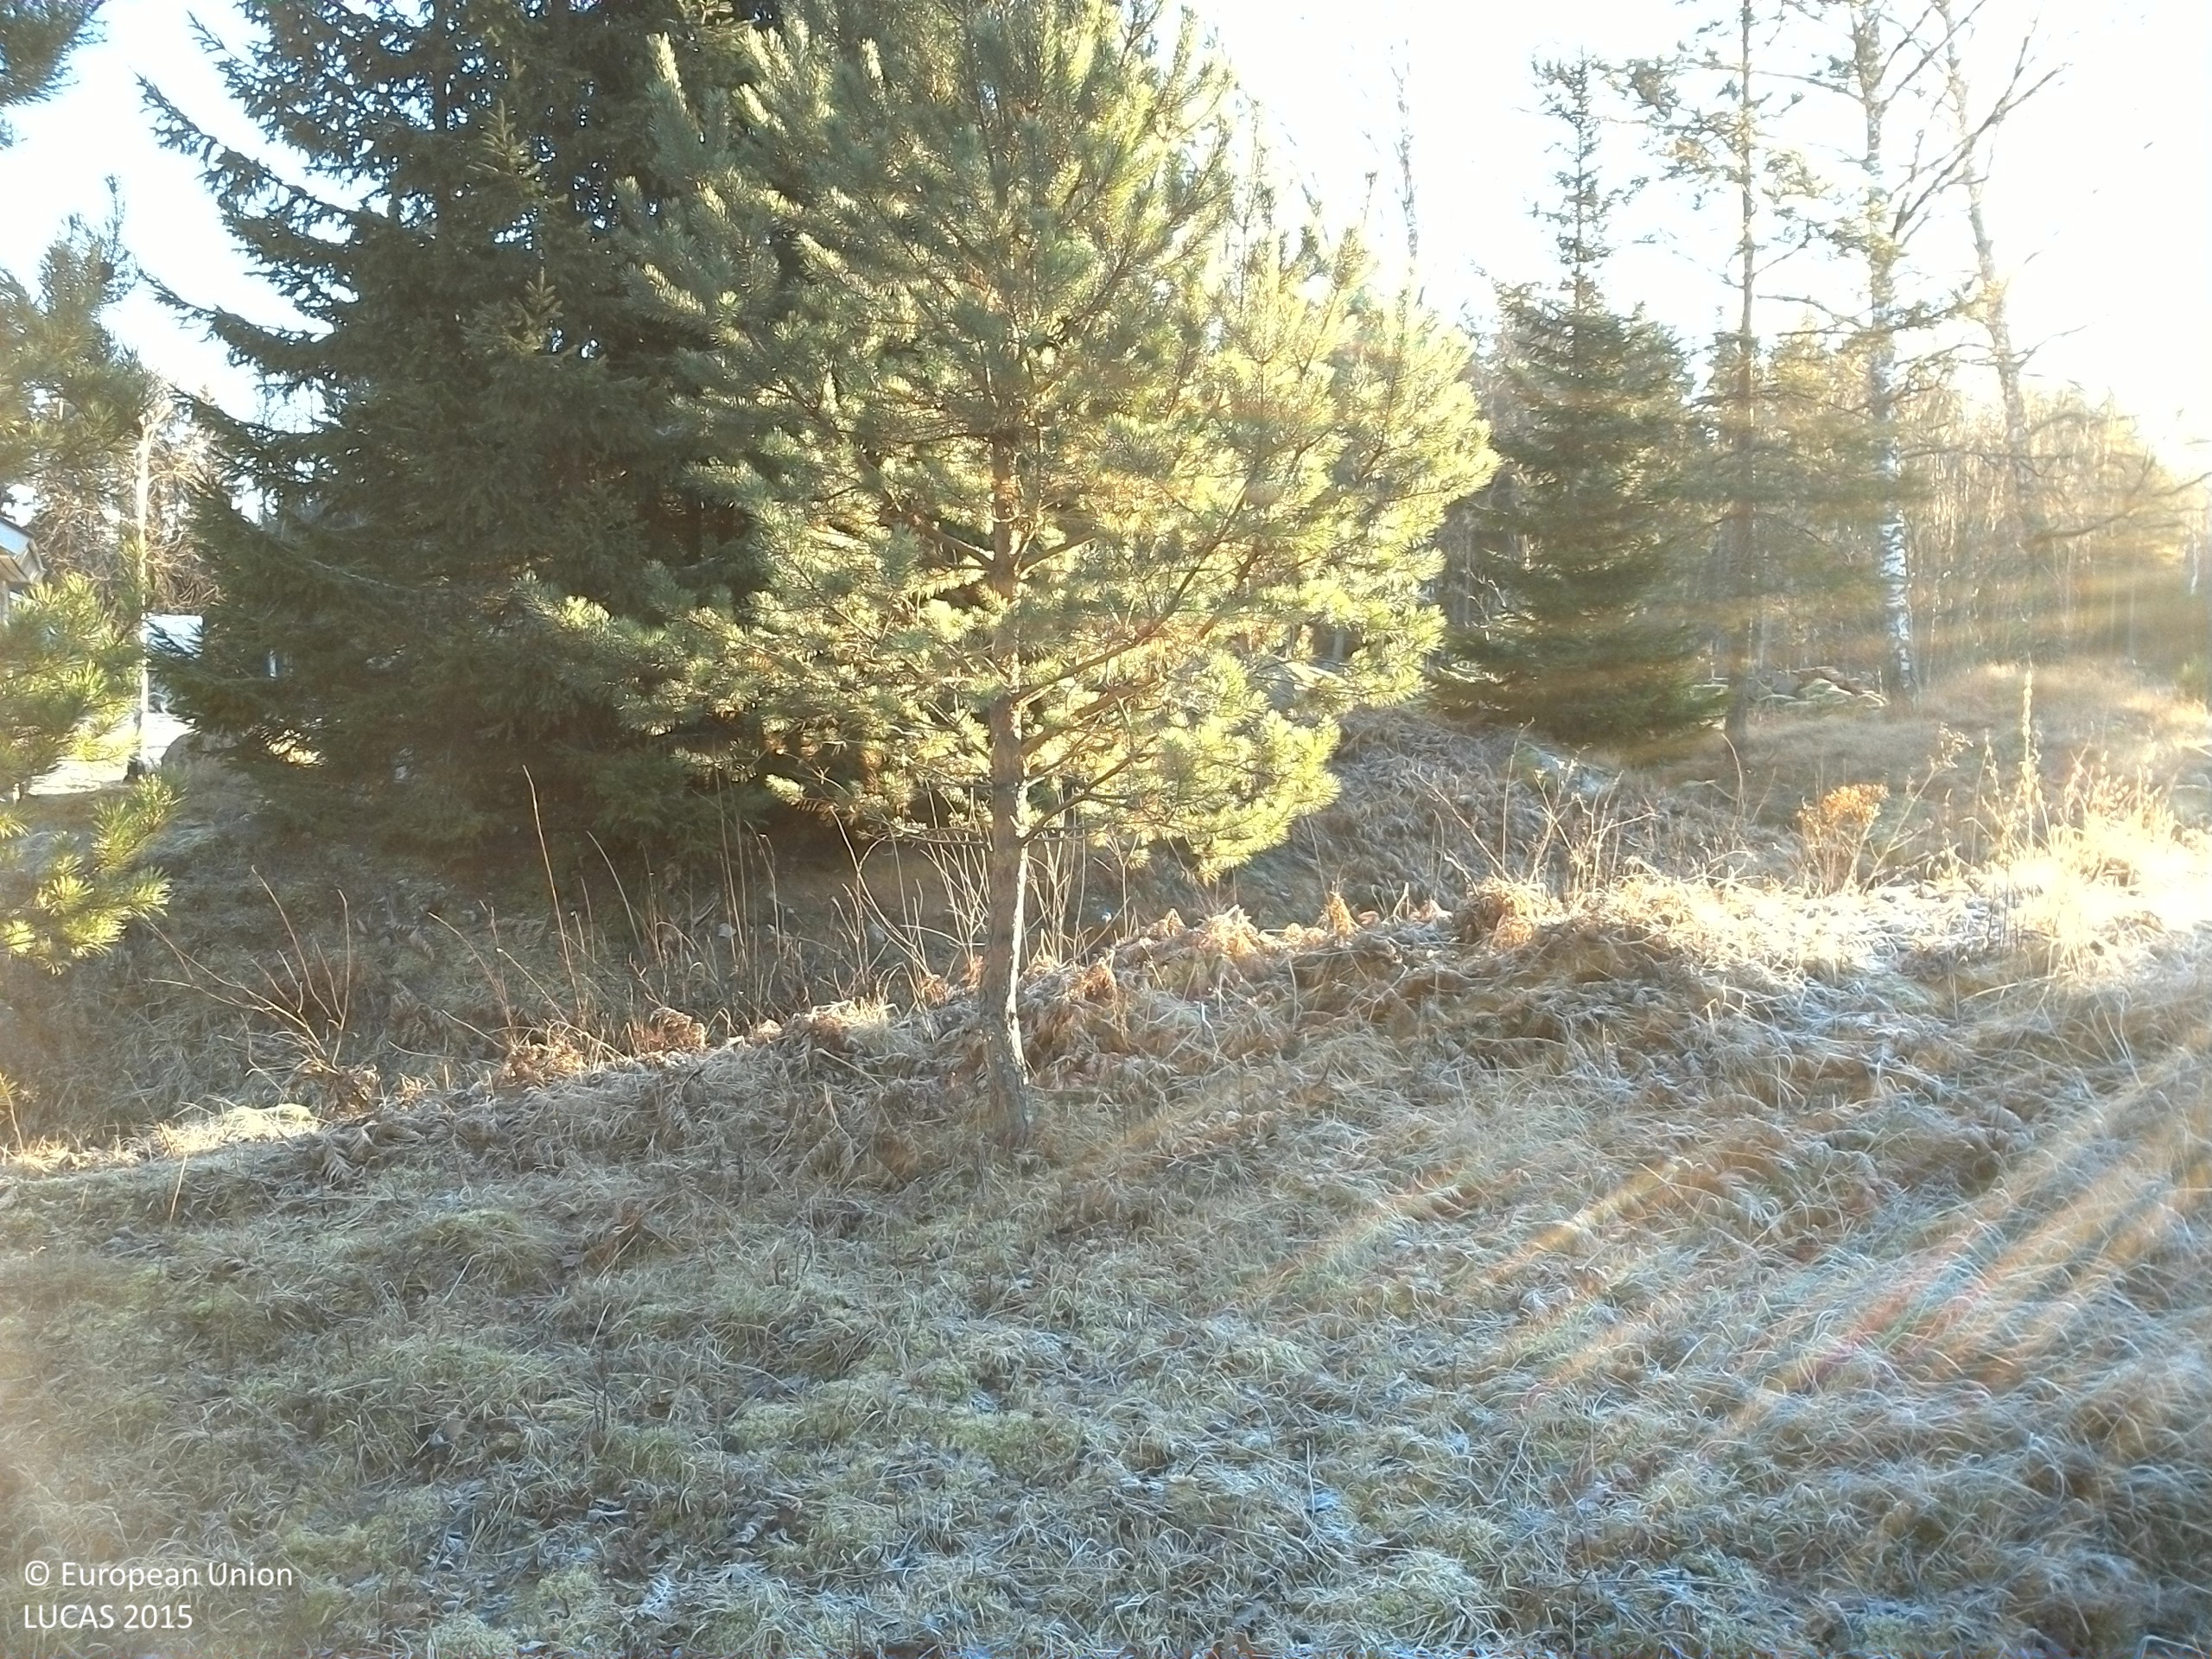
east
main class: Grassland
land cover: Grassland with sparse tree/shrub cover
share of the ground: > 75 %
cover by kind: herbaceous plants 95 %, coniferous forest trees 5 %
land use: Residential
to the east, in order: Grassland with sparse tree/shrub cover; Ditches and canals; Artificial constructions in urban areas; Broadleaved woodland; Other mixed woodland; Other coniferous woodland; Tracks; Broadleaved woodland; Other mixed woodland; Other coniferous woodland; Pine dominated mixed woodland; Grassland without tree/shrub cover
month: December
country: SE
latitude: 59.3354
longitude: 16.3035
